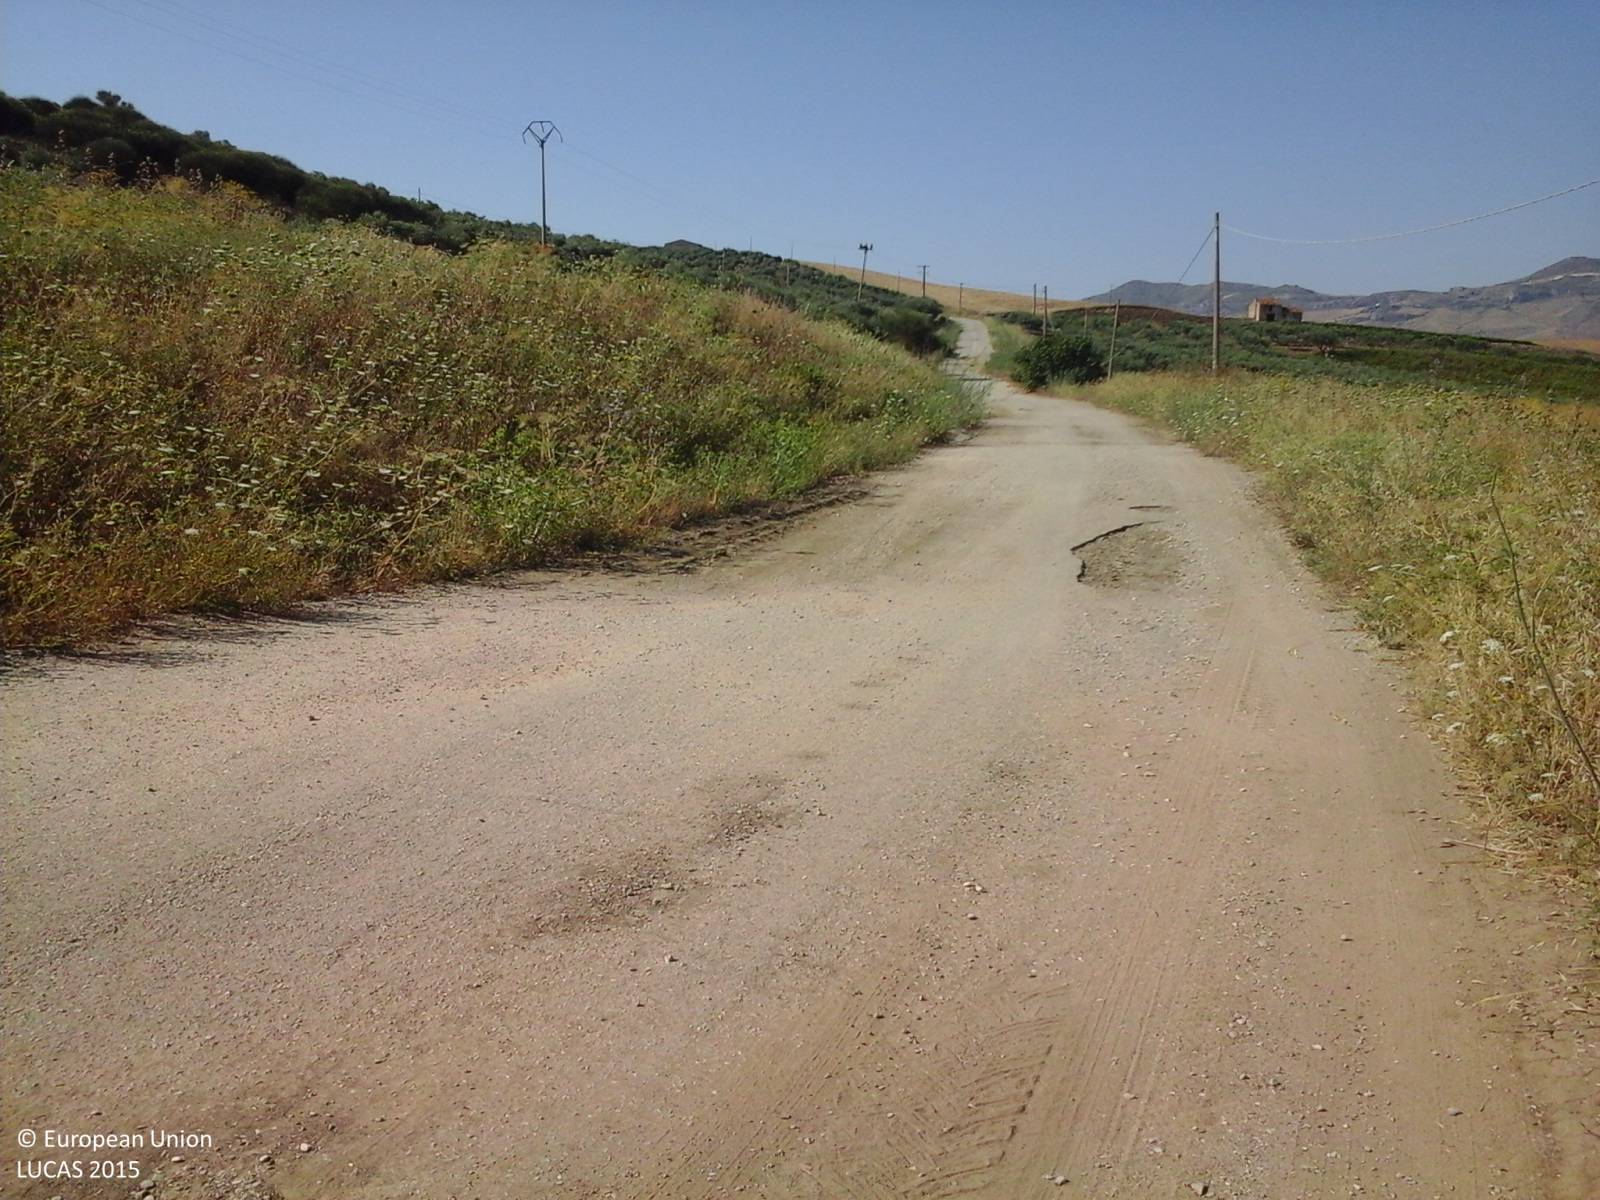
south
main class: Grassland
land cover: Spontaneously vegetated surfaces
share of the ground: > 75 %
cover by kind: herbaceous plants 95 %, shrubs 5 %
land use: Semi-natural and natural areas not in use
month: July
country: IT
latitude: 37.8437
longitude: 13.0572
